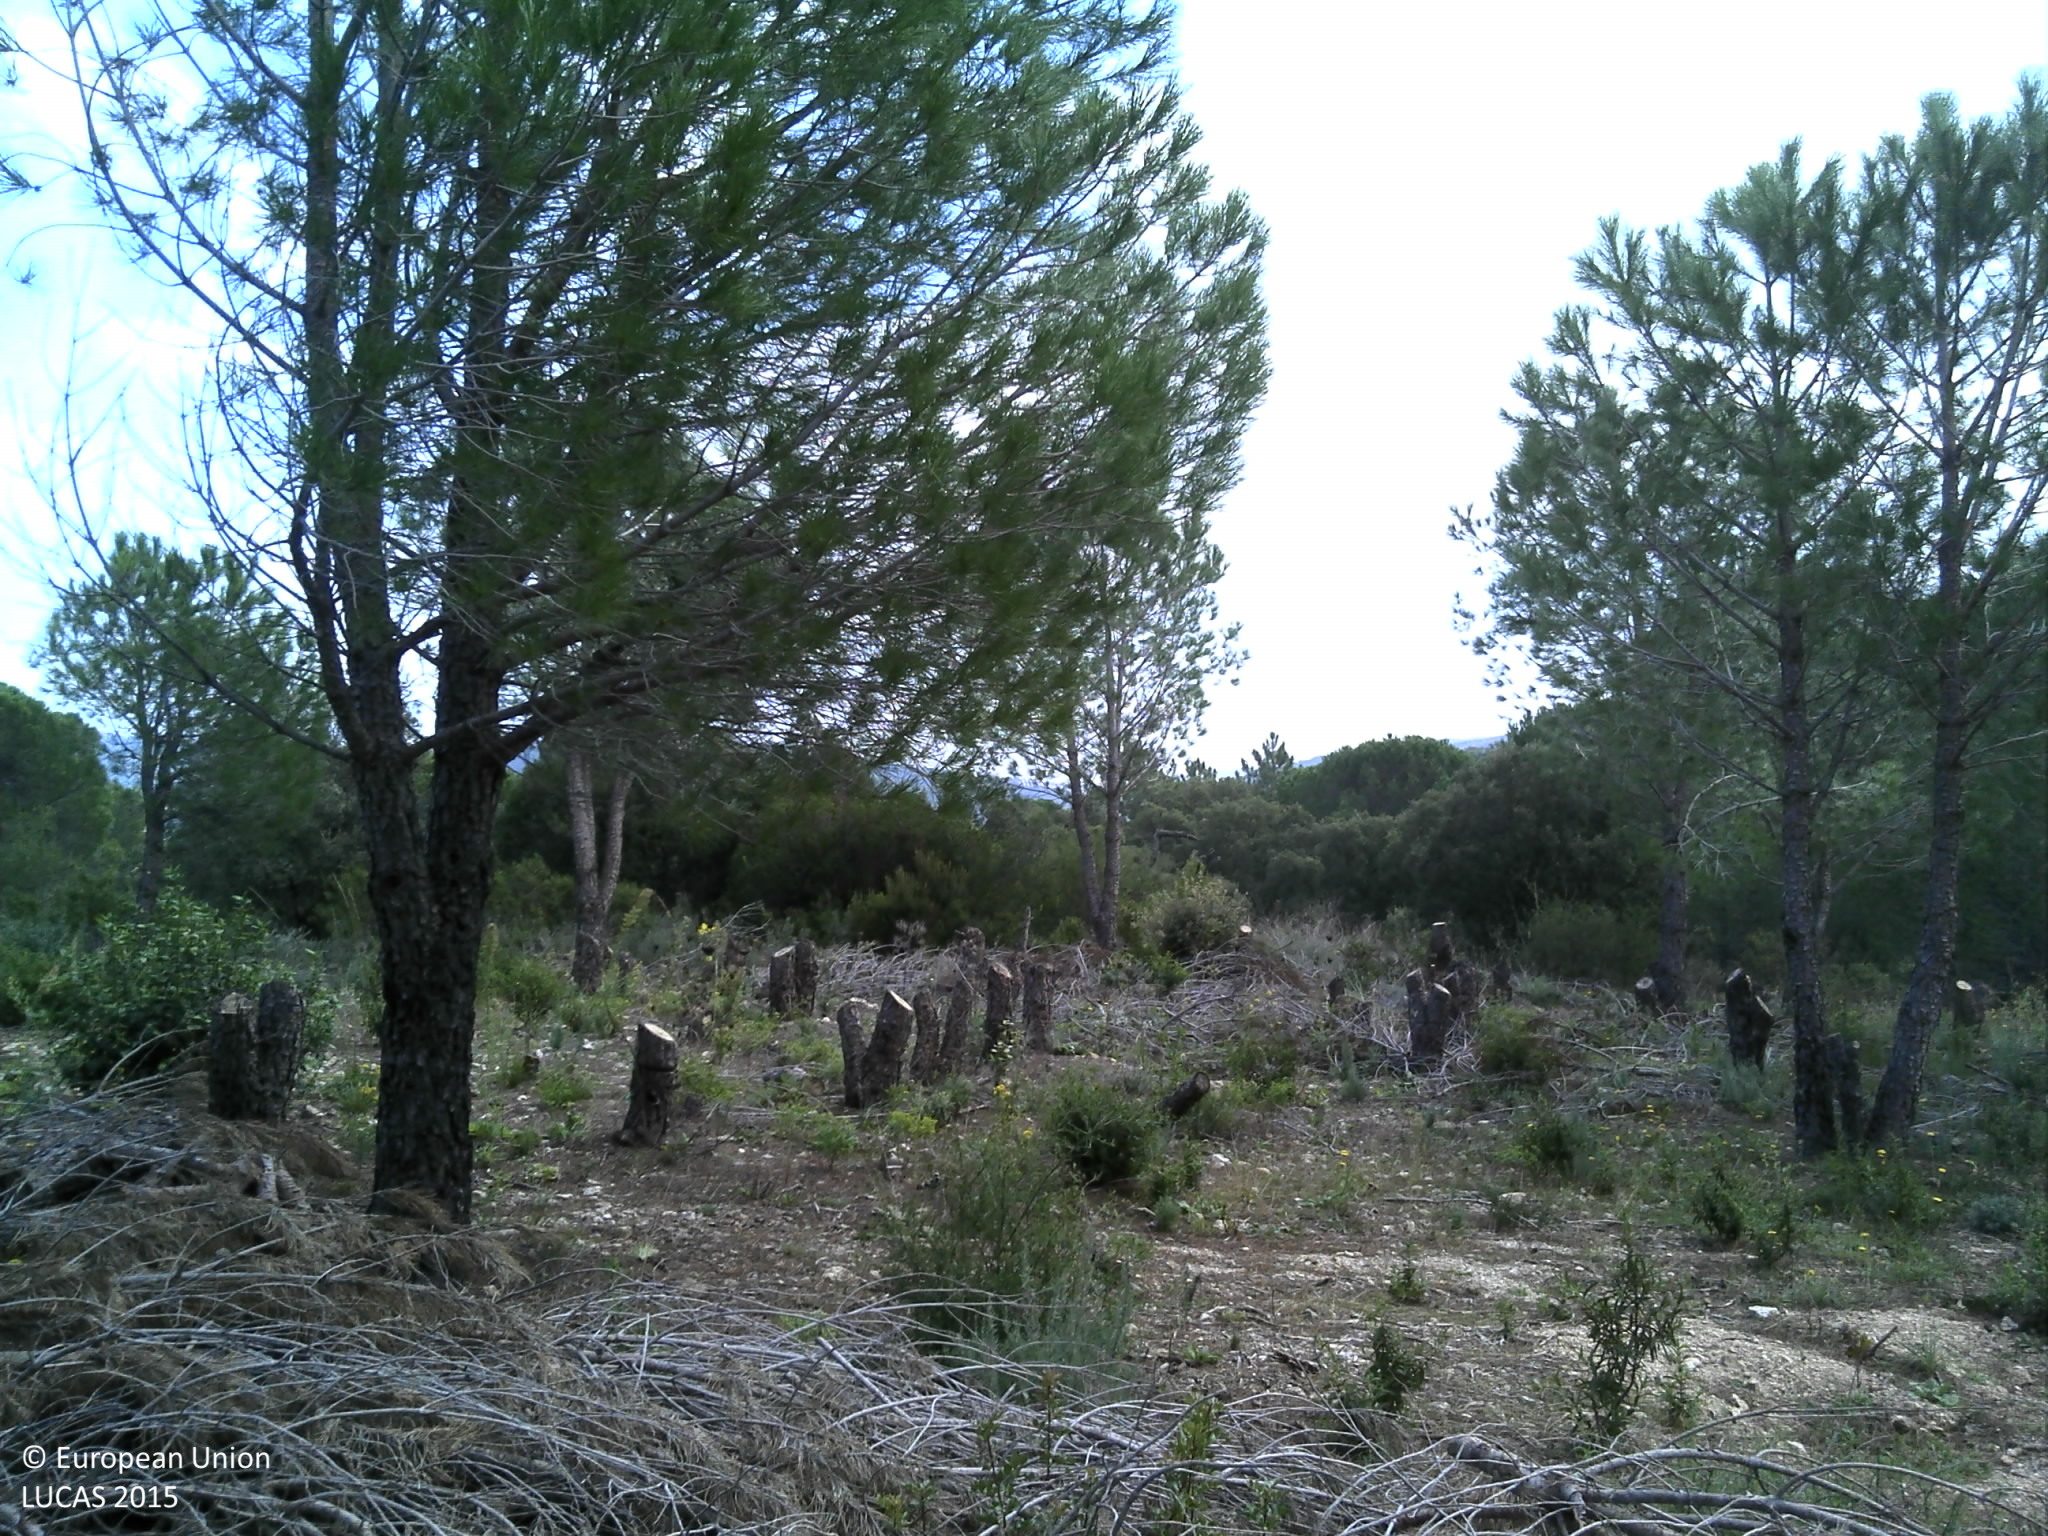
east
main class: Woodland
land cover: Pine dominated coniferous woodland
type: coniferous forest of the mediterranean region
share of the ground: 50 - 75 %
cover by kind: coniferous forest trees 50 %, unconsolidated bare surface 30 %, shrubs 10 %, herbaceous plants 5 %
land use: Forestry
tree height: > 5 m
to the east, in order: Pine dominated coniferous woodland; Shrubland with sparse tree cover; Pine dominated mixed woodland; Fences; Tracks; Fences; Pine dominated mixed woodland; Grassland with sparse tree/shrub cover; Fences; Paved roads, cycling and walking lanes
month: October
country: FR
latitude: 43.3359
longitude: 6.5429
